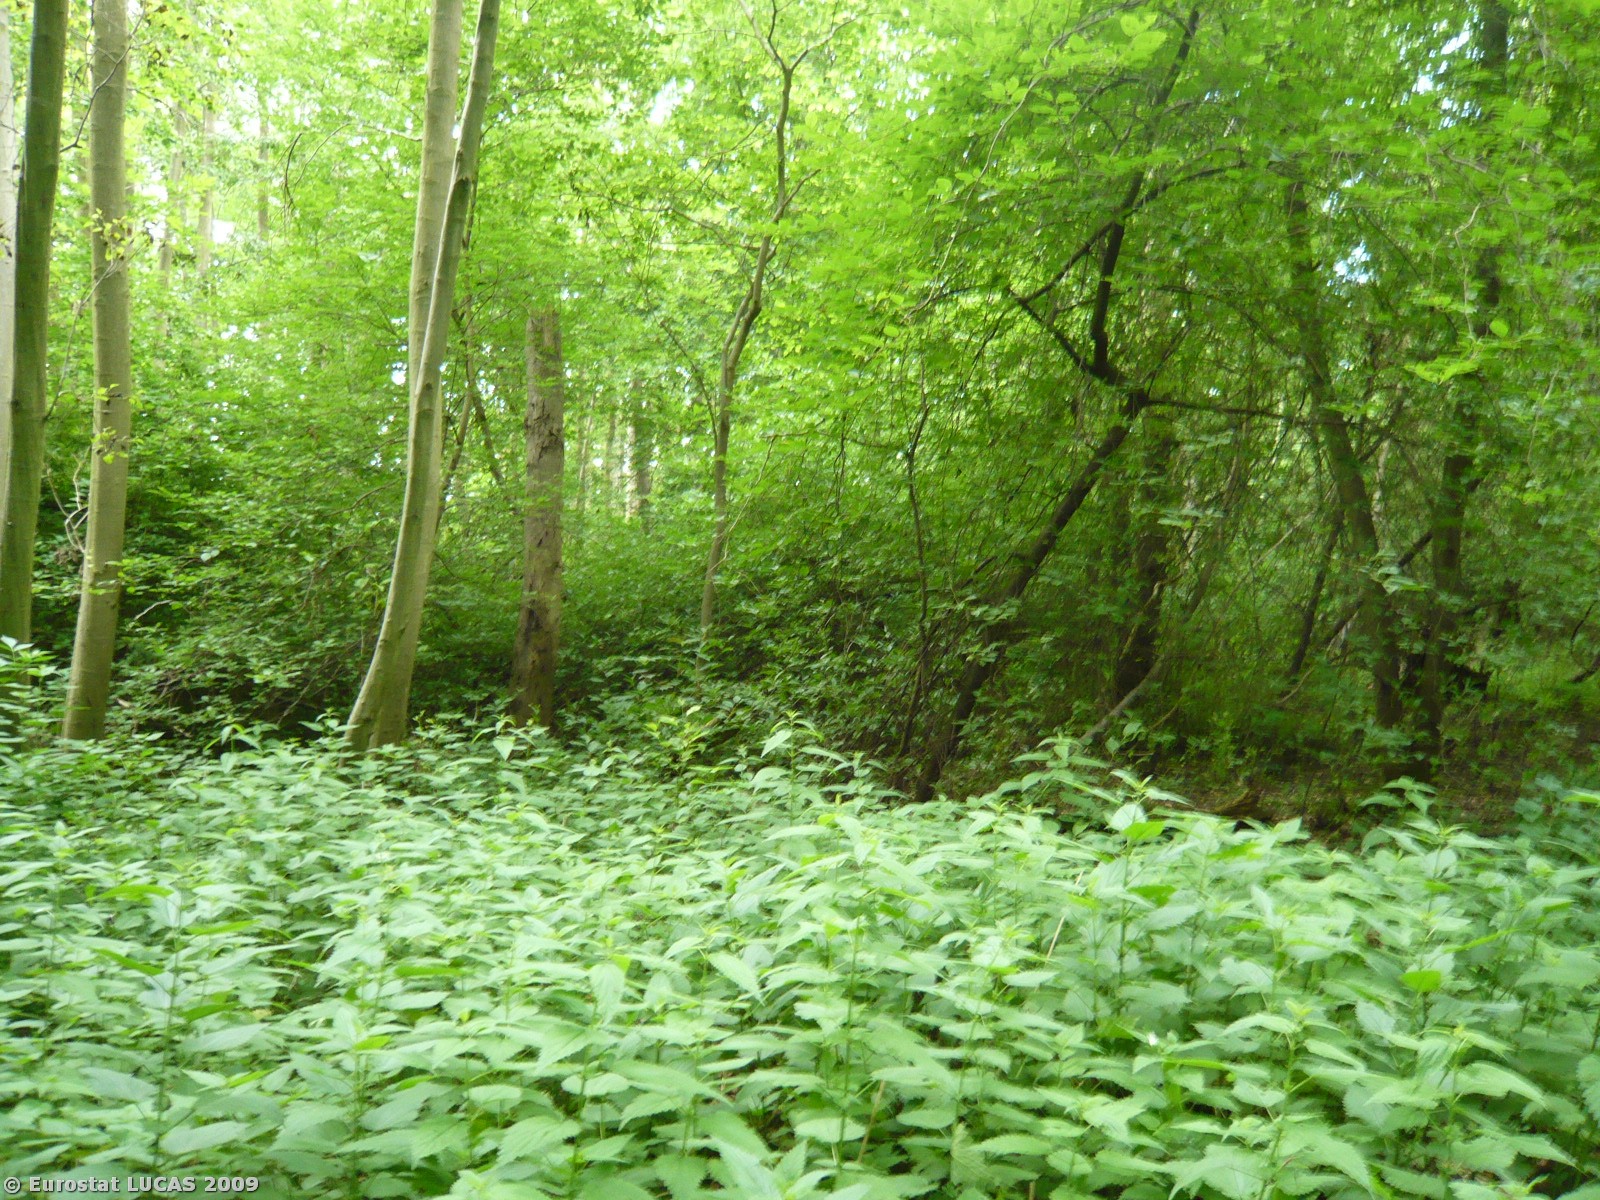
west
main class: Woodland
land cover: Broadleaved woodland
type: mesophytic deciduous forest
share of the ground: > 75 %
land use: Forestry
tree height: > 5 m
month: June
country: DK
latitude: 54.7747
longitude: 11.6623
